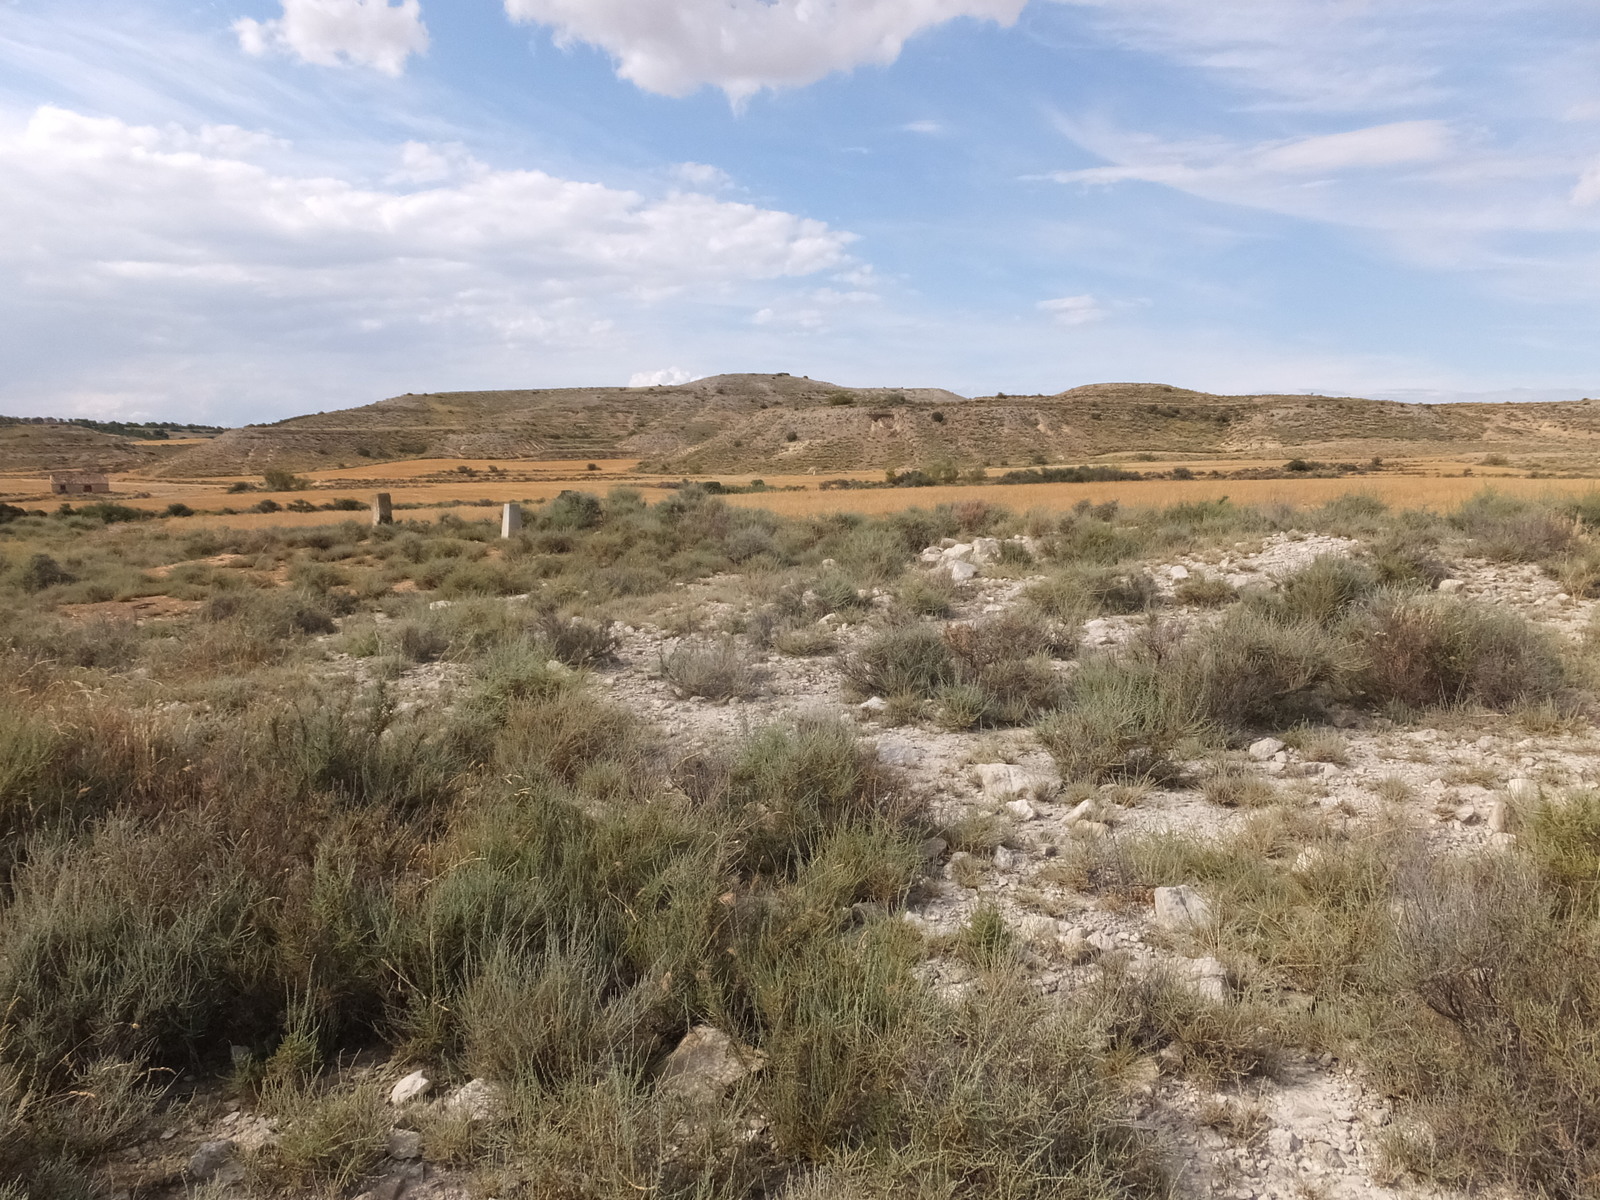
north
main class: Shrubland
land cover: Shrubland with sparse tree cover
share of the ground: 50 - 75 %
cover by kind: shrubs 60 %, herbaceous plants 35 %, coniferous forest trees 5 %
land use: Semi-natural and natural areas not in use
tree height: < 5 m
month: June
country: ES
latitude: 41.5622
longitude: 0.0447
